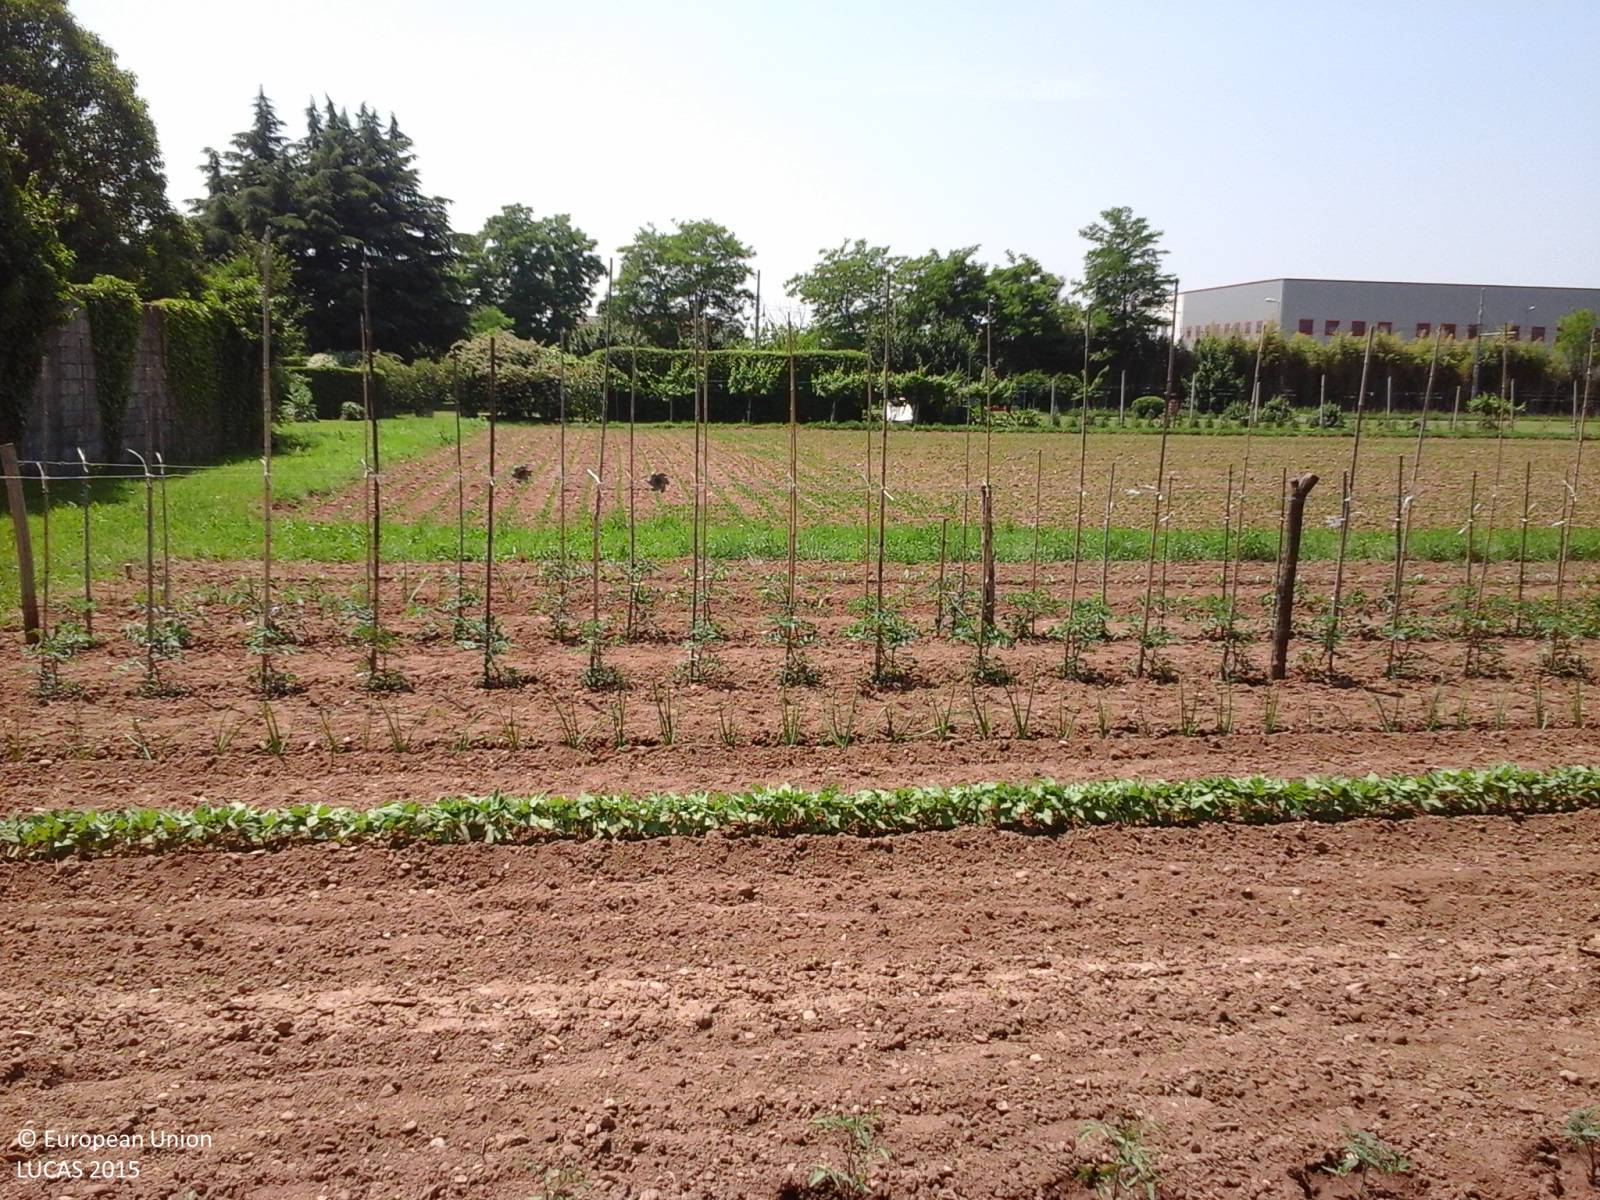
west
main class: Grassland
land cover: Grassland with sparse tree/shrub cover
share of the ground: > 75 %
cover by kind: herbaceous plants 90 %, broadleaved forest trees 5 %, shrubs 5 %
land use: Residential
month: June
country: IT
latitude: 45.9770
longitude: 13.2618
